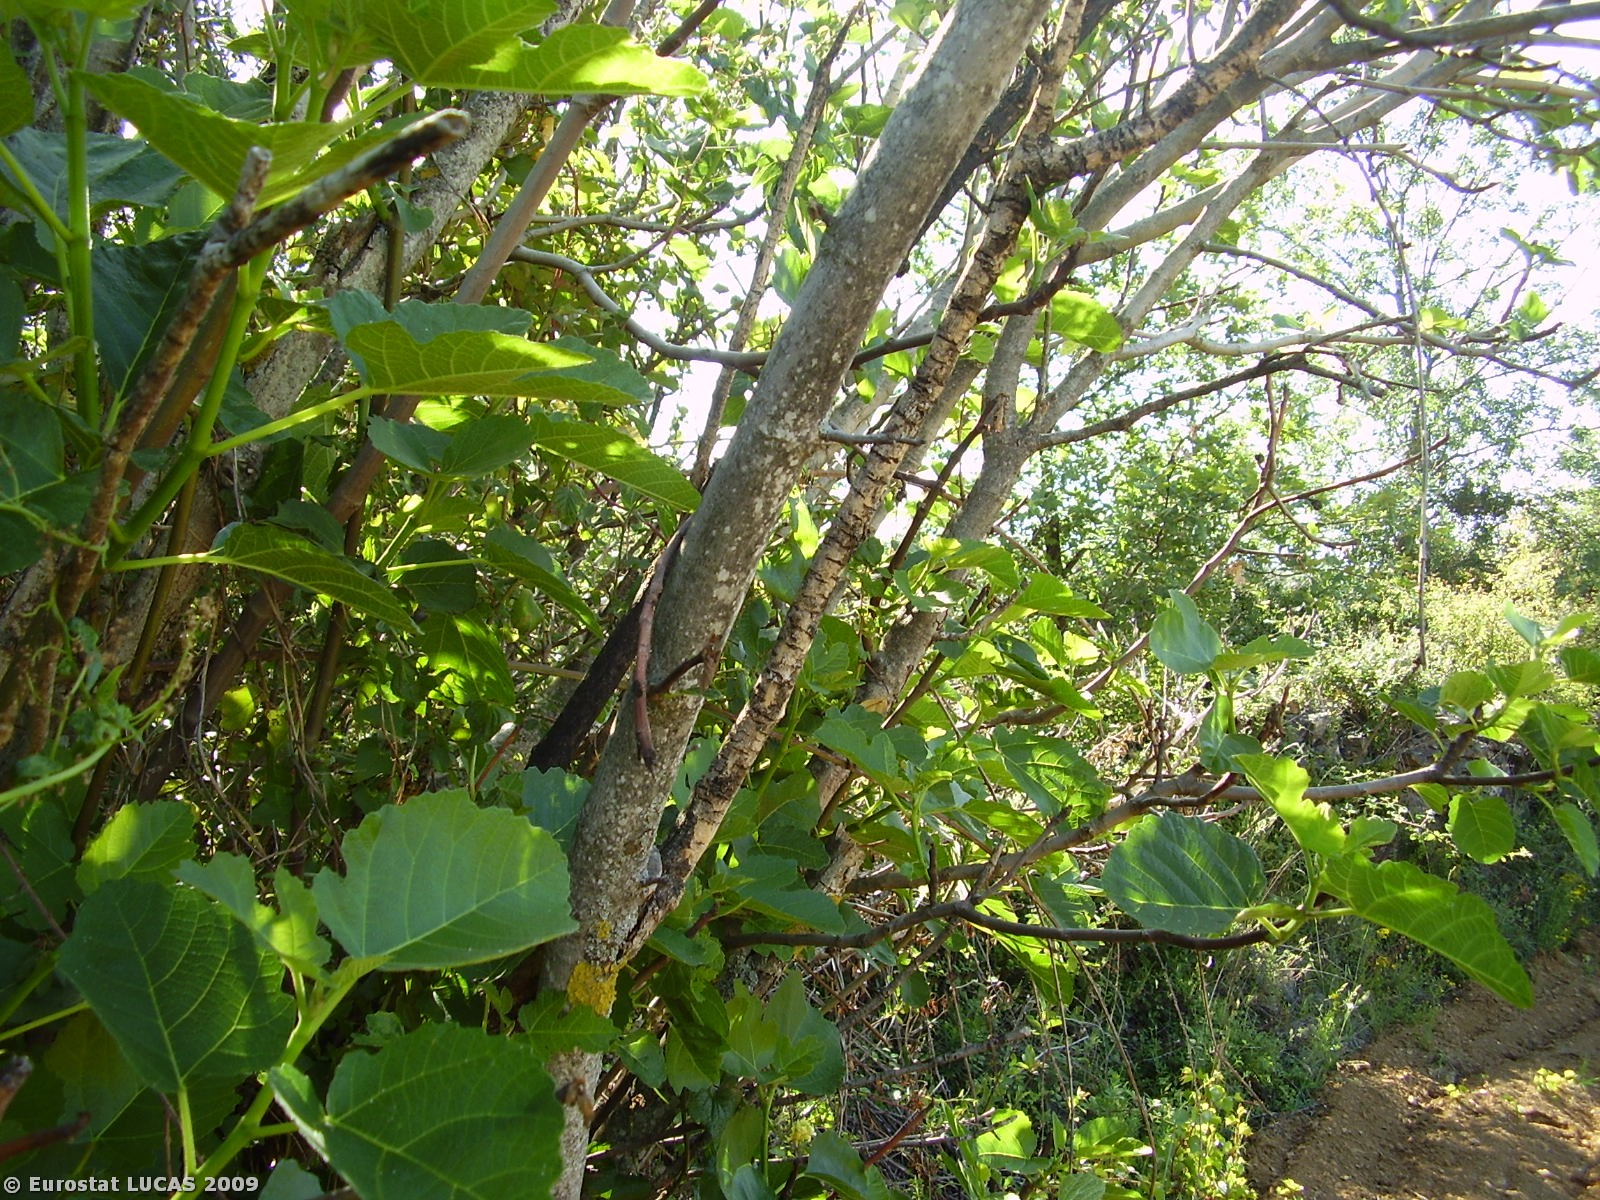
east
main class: Cropland
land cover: Vineyards
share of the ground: 25 - 50 %
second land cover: Bare land
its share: 10 - 25 %
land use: Agriculture (excluding fallow land and kitchen gardens)
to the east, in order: Vineyards; Bare land; Single bushes/trees; Shruby margins; Dry stone walls; Grass margins; Tracks; Shruby margins; Single bushes/trees; Dry stone walls; Grass margins; Bare land; Broadleaved woodland; Shrubland without tree cover; Bare land; Maize
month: June
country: PT
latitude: 41.8015
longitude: -6.9555
